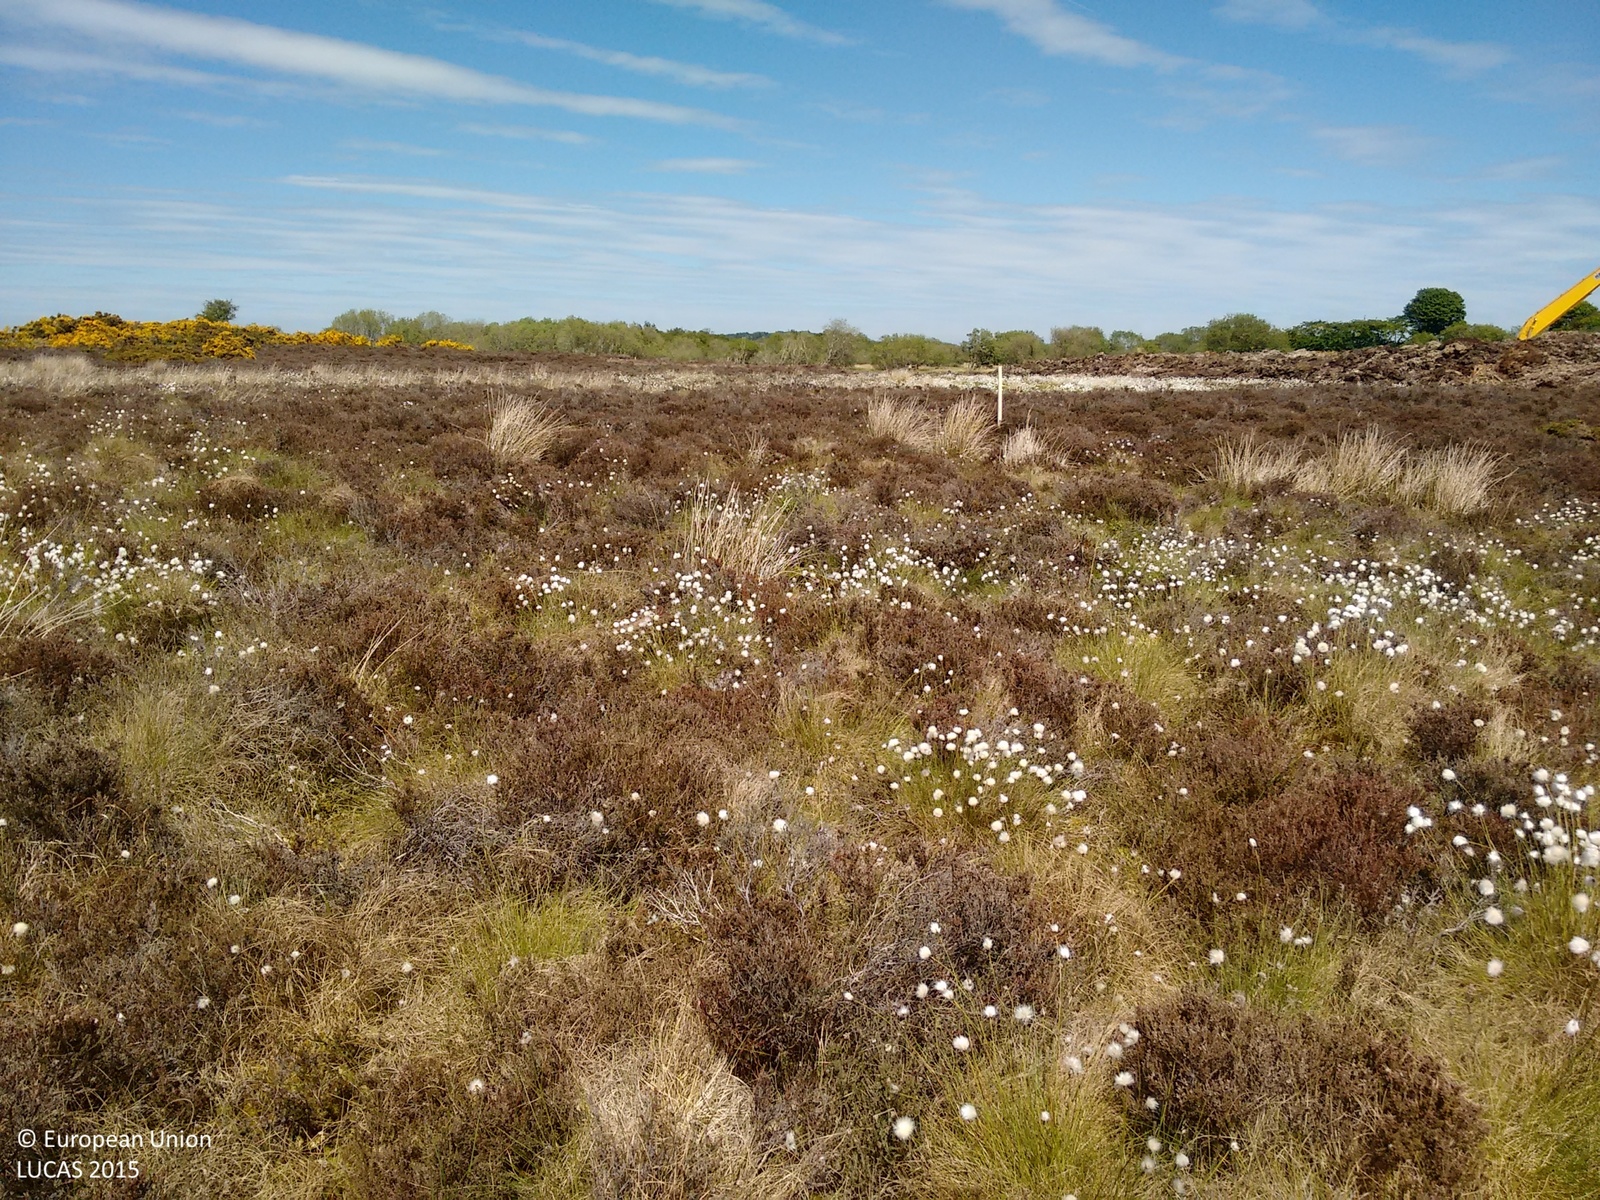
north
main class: Shrubland
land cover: Shrubland without tree cover
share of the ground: > 75 %
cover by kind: shrubs 65 %, herbaceous plants 20 %, lichens and mosses 15 %
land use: Semi-natural and natural areas not in use
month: June
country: GB
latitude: 57.0036
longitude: -2.2177
